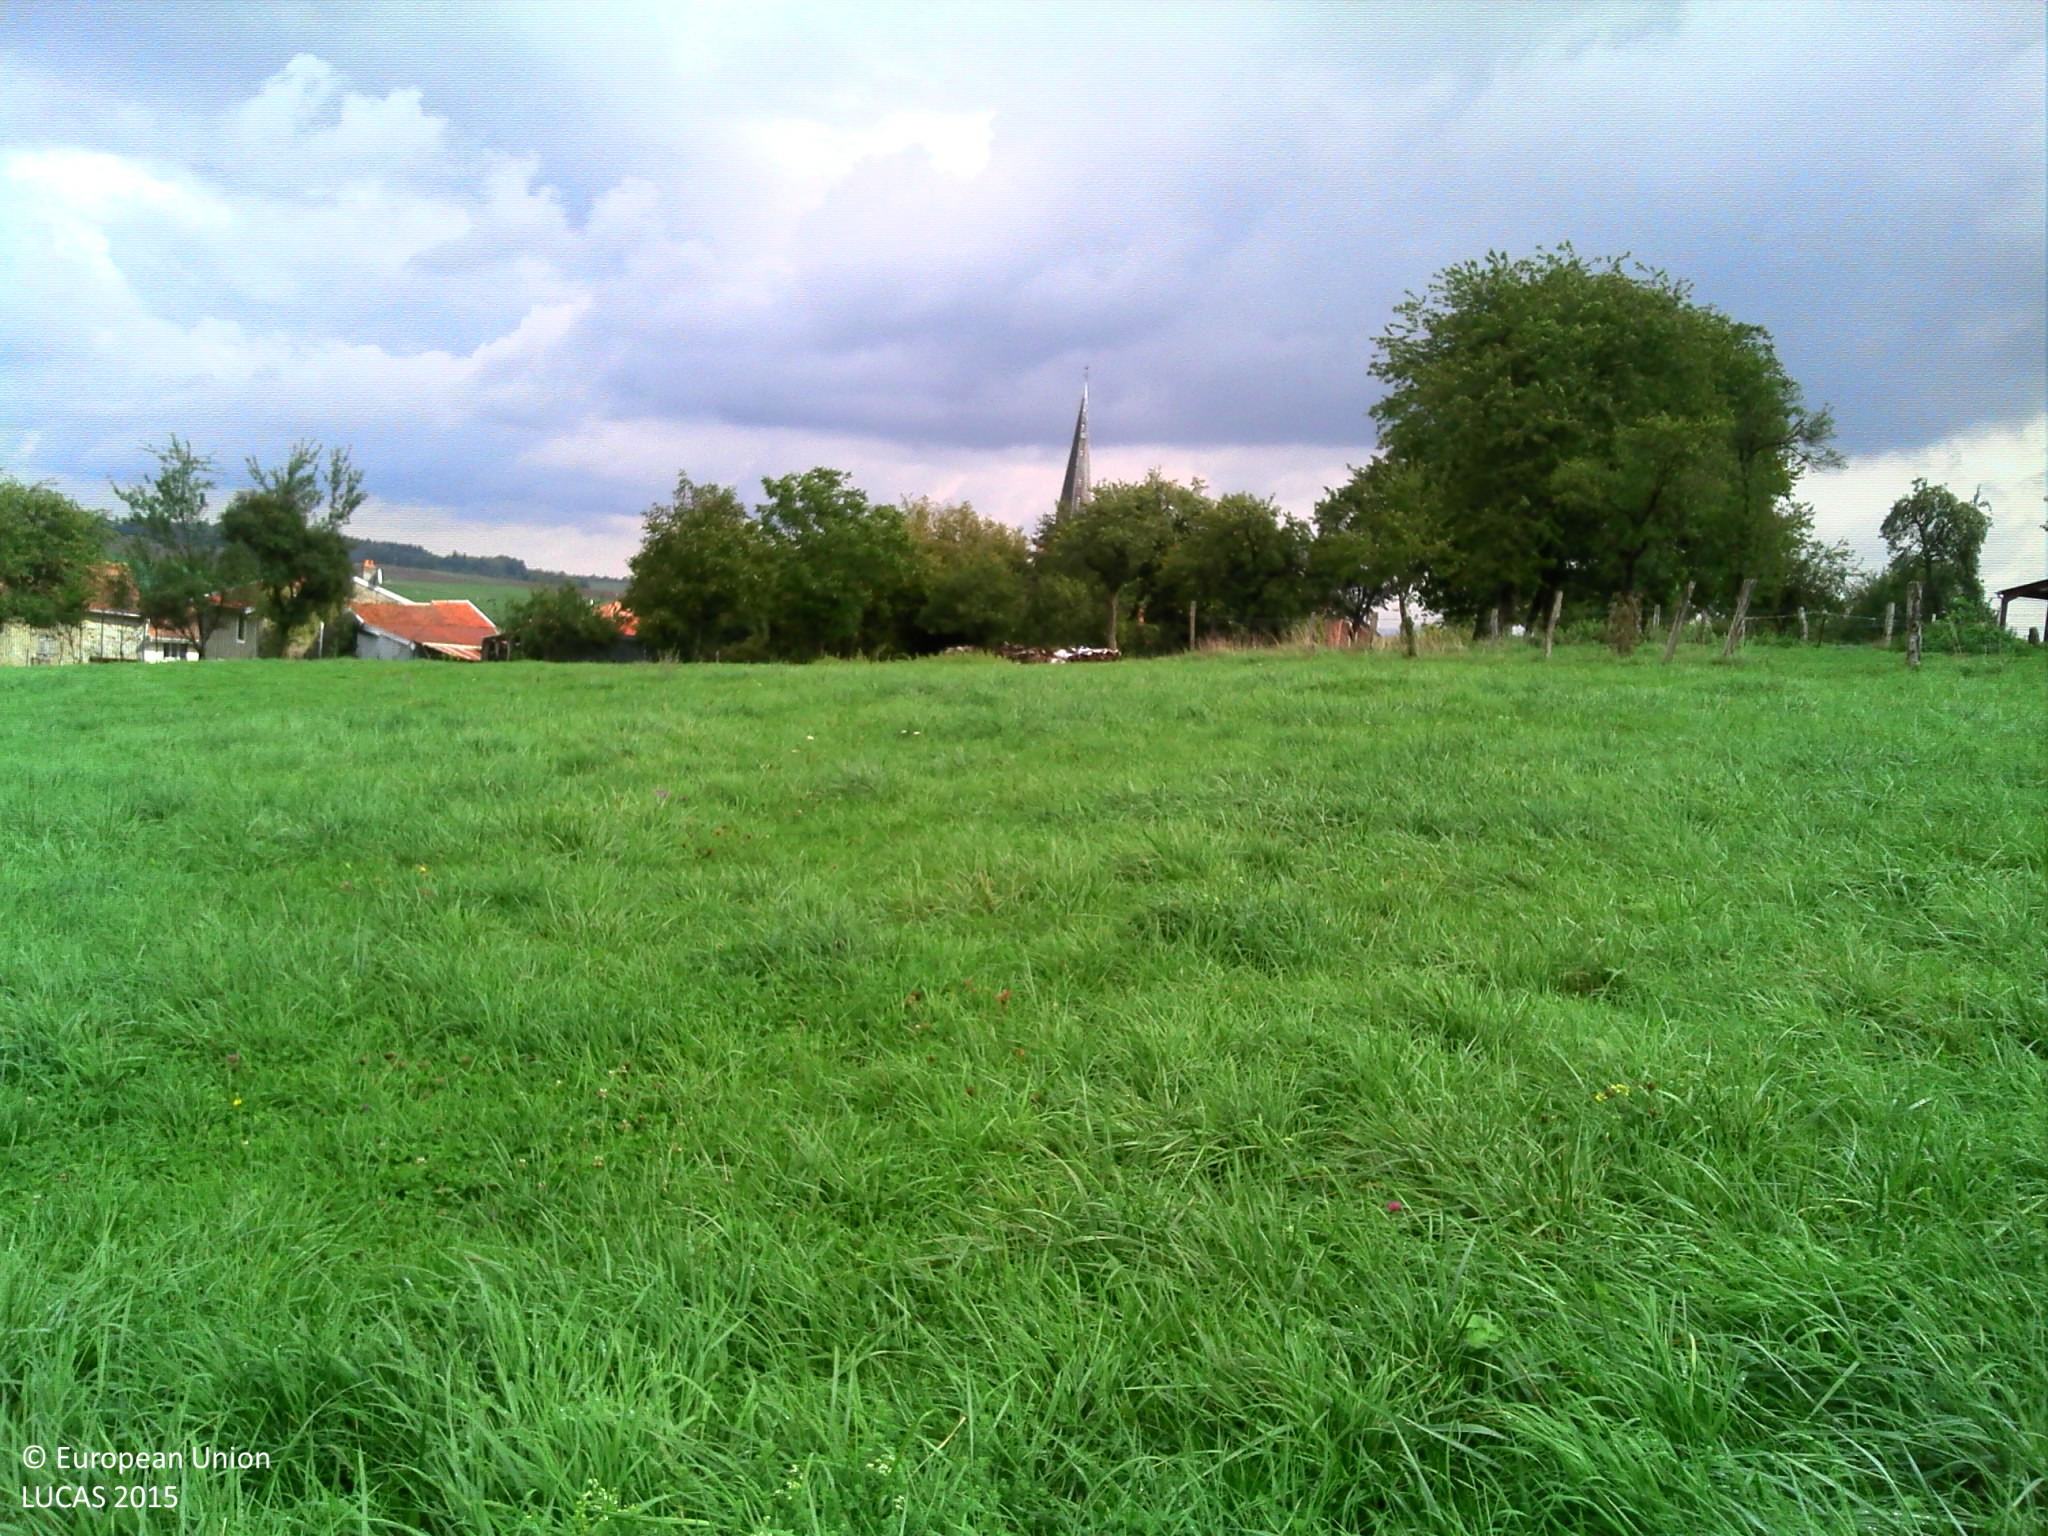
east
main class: Grassland
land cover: Grassland without tree/shrub cover
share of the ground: > 75 %
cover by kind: herbaceous plants 95 %, consolidated bare surface 5 %
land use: Agriculture (excluding fallow land and kitchen gardens)
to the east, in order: Grassland without tree/shrub cover; Fences; Grassland without tree/shrub cover; Fences; Grassland with sparse tree/shrub cover; Fences; Broadleaved woodland; Artificial constructions in urban areas
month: September
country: FR
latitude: 48.5745
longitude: 6.8426
